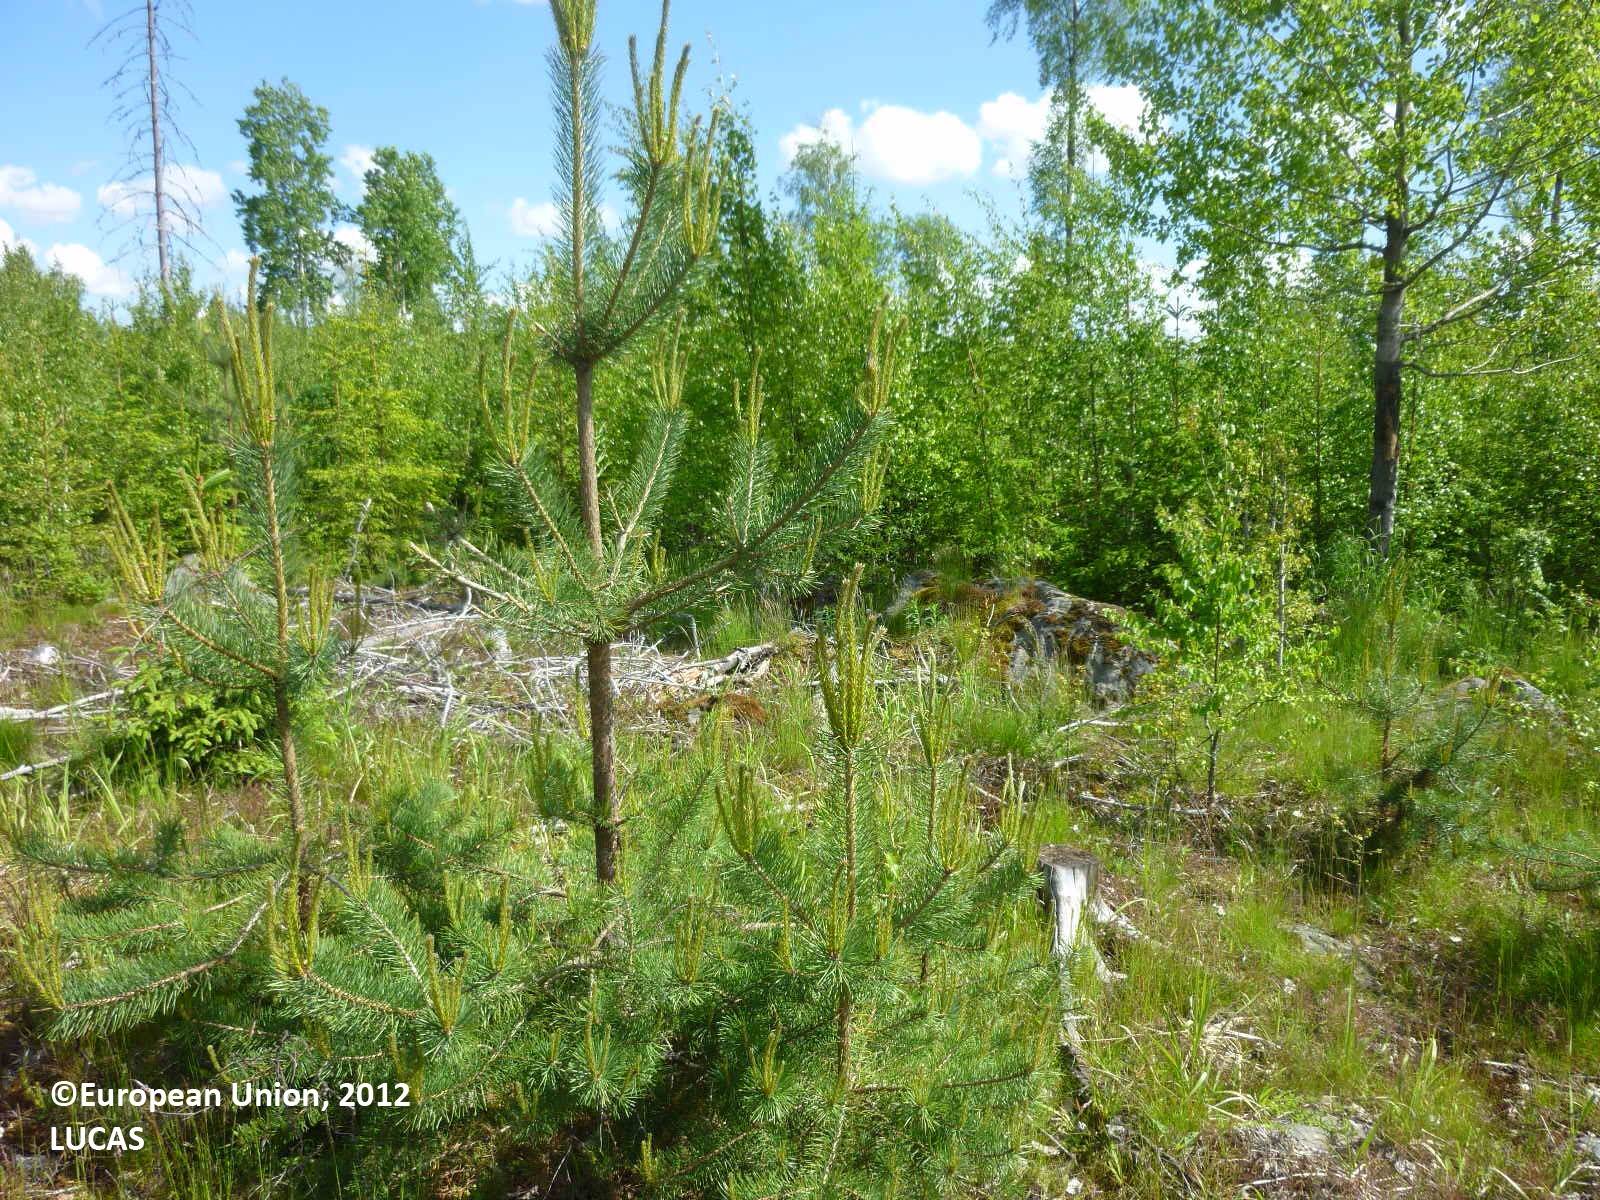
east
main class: Woodland
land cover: Broadleaved woodland
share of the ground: 25 - 50 %
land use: Forestry
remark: Clear cut
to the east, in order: Broadleaved woodland; Ditches and canals; Grass margins; Temporary grasslands; Grass margins; Ditches and canals
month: June
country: FI
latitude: 61.4507
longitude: 22.6901
